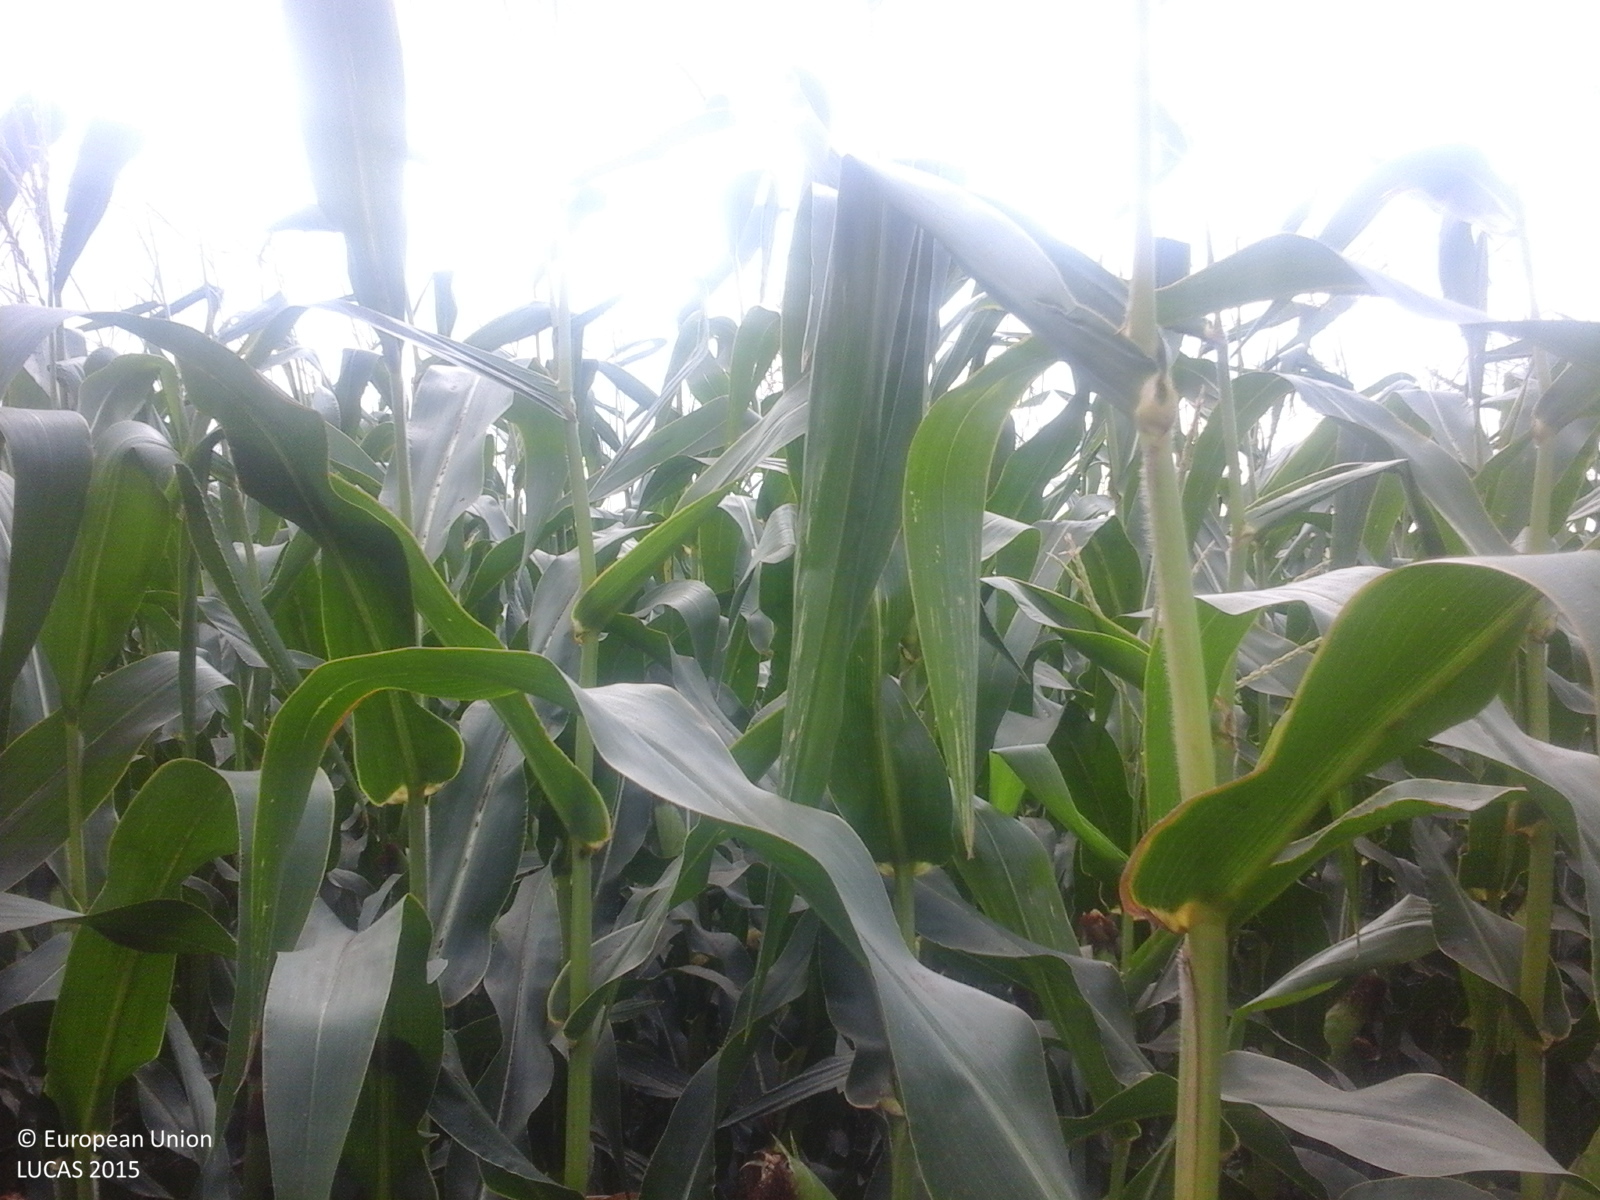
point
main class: Cropland
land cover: Maize
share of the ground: > 75 %
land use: Agriculture (excluding fallow land and kitchen gardens)
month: August
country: RO
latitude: 44.6289
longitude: 28.2813
